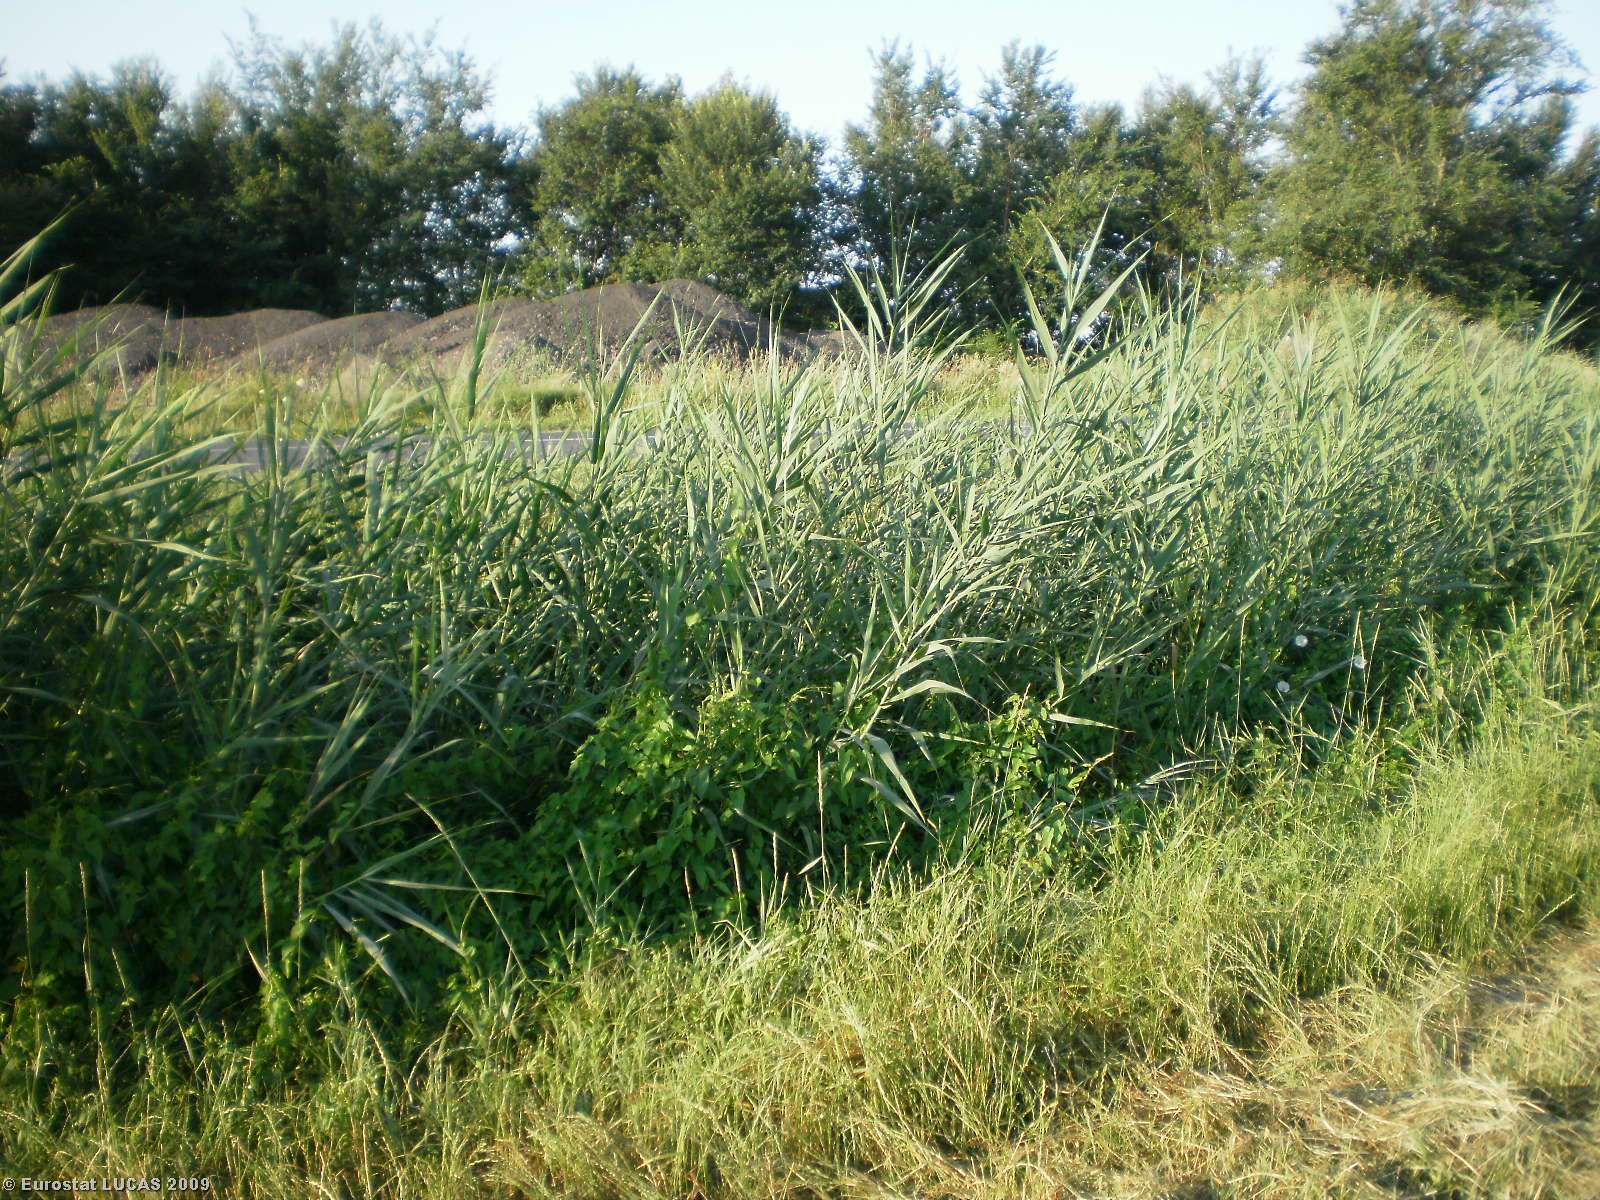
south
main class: Cropland
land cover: Maize
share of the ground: > 75 %
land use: Agriculture (excluding fallow land and kitchen gardens)
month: June
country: IT
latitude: 45.1796
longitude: 10.2667
